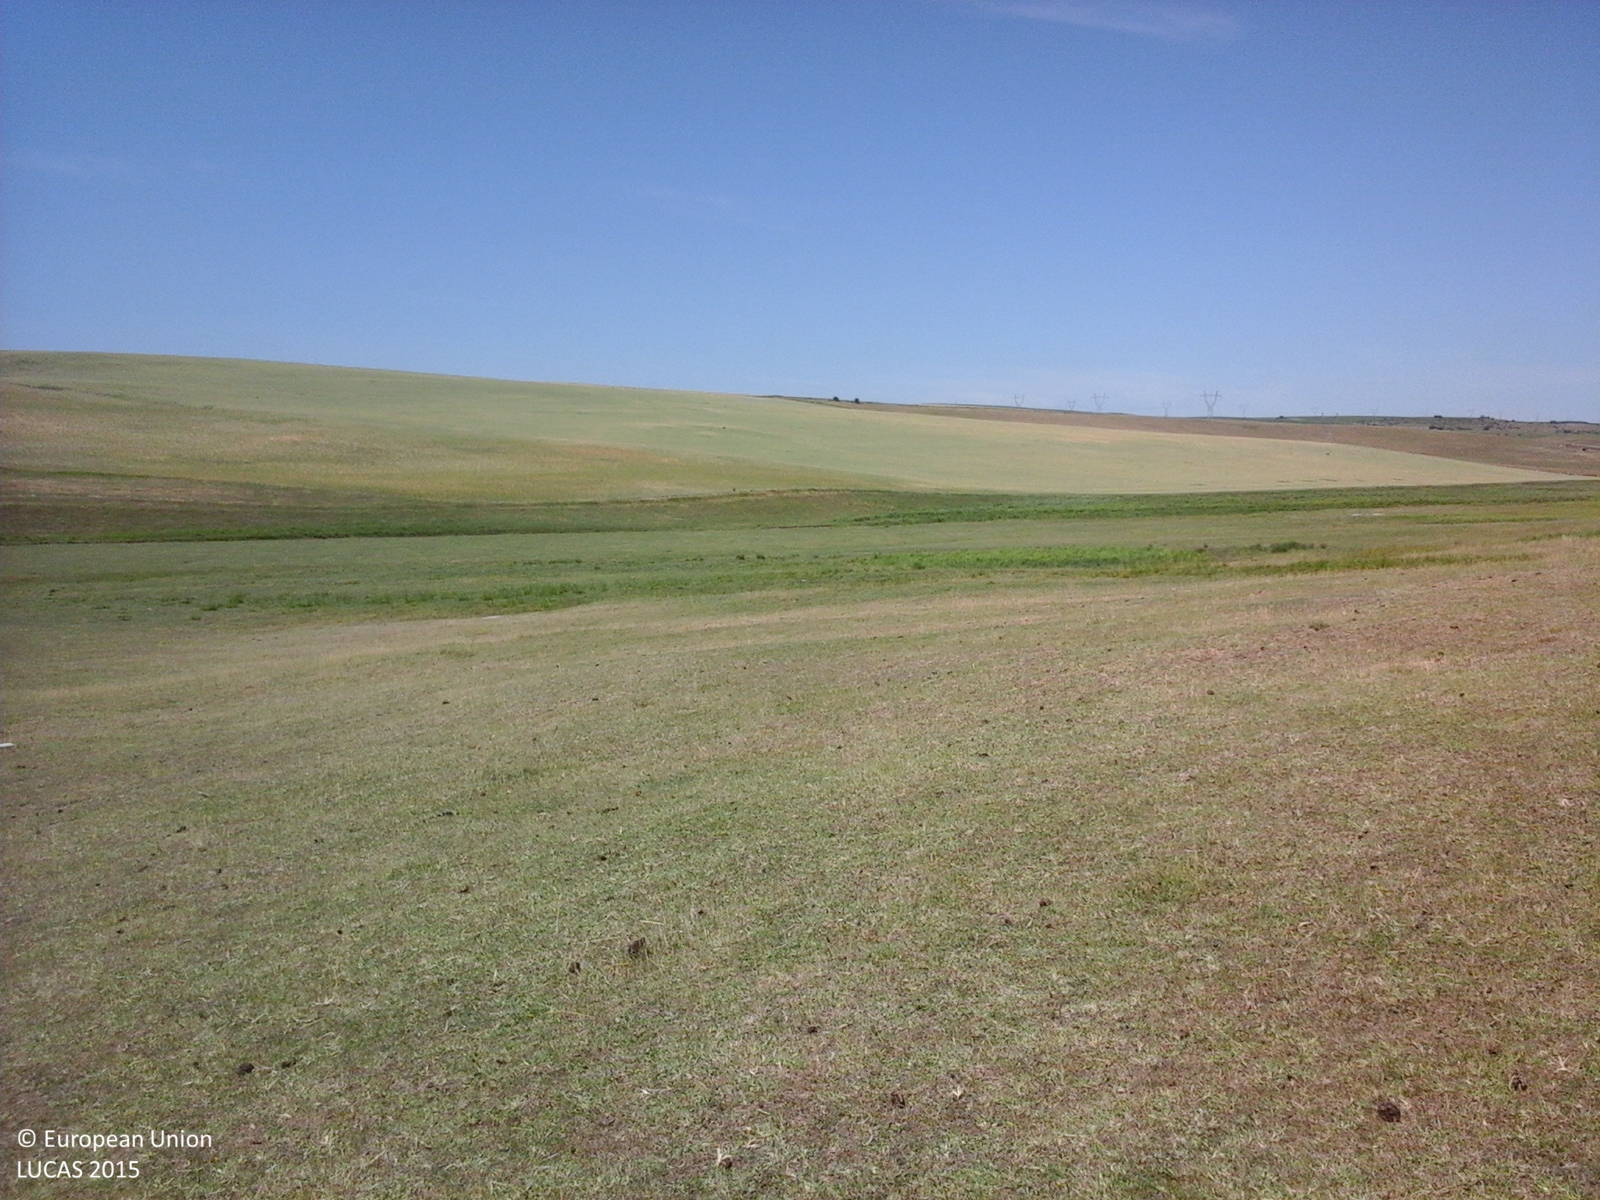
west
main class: Grassland
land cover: Grassland without tree/shrub cover
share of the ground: > 75 %
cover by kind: herbaceous plants 100 %
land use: Agriculture (excluding fallow land and kitchen gardens)
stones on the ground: 10 - 25 %
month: June
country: RO
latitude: 47.2440
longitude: 26.9713
